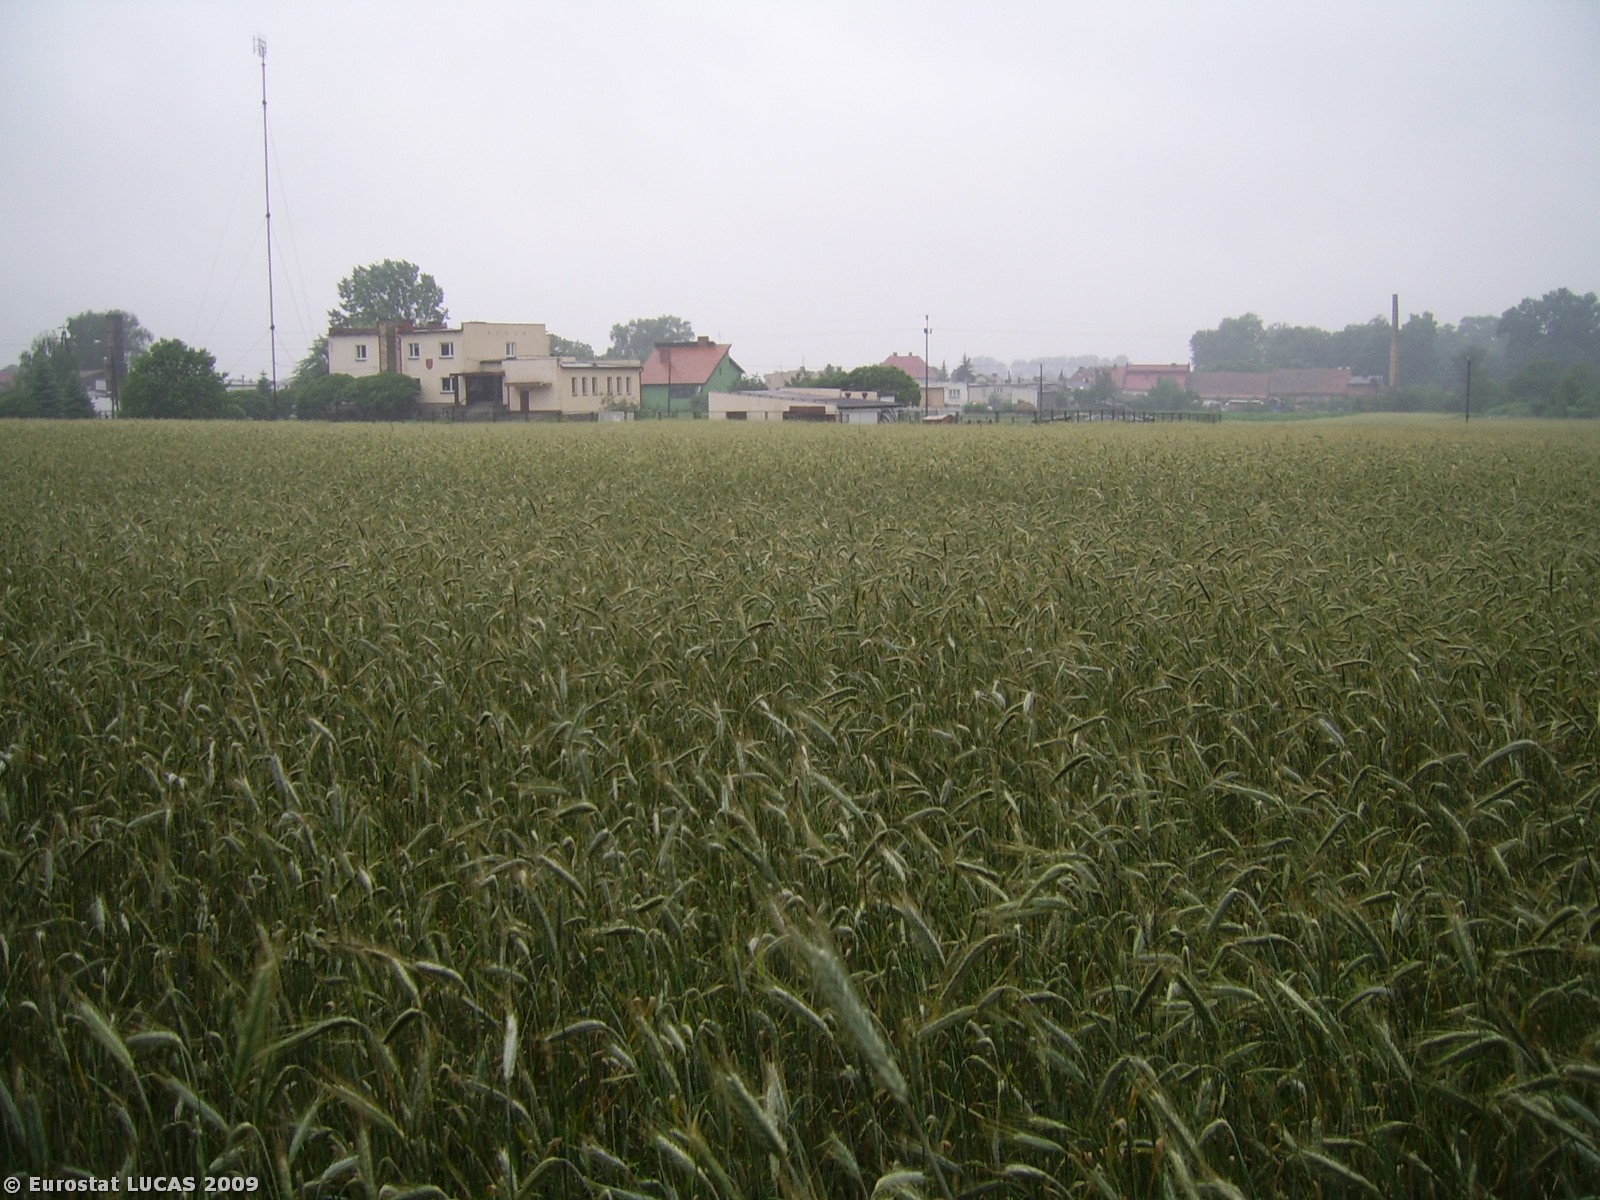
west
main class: Cropland
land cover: Rye
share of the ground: > 75 %
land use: Agriculture (excluding fallow land and kitchen gardens)
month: June
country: PL
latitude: 51.6251
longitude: 17.3646
